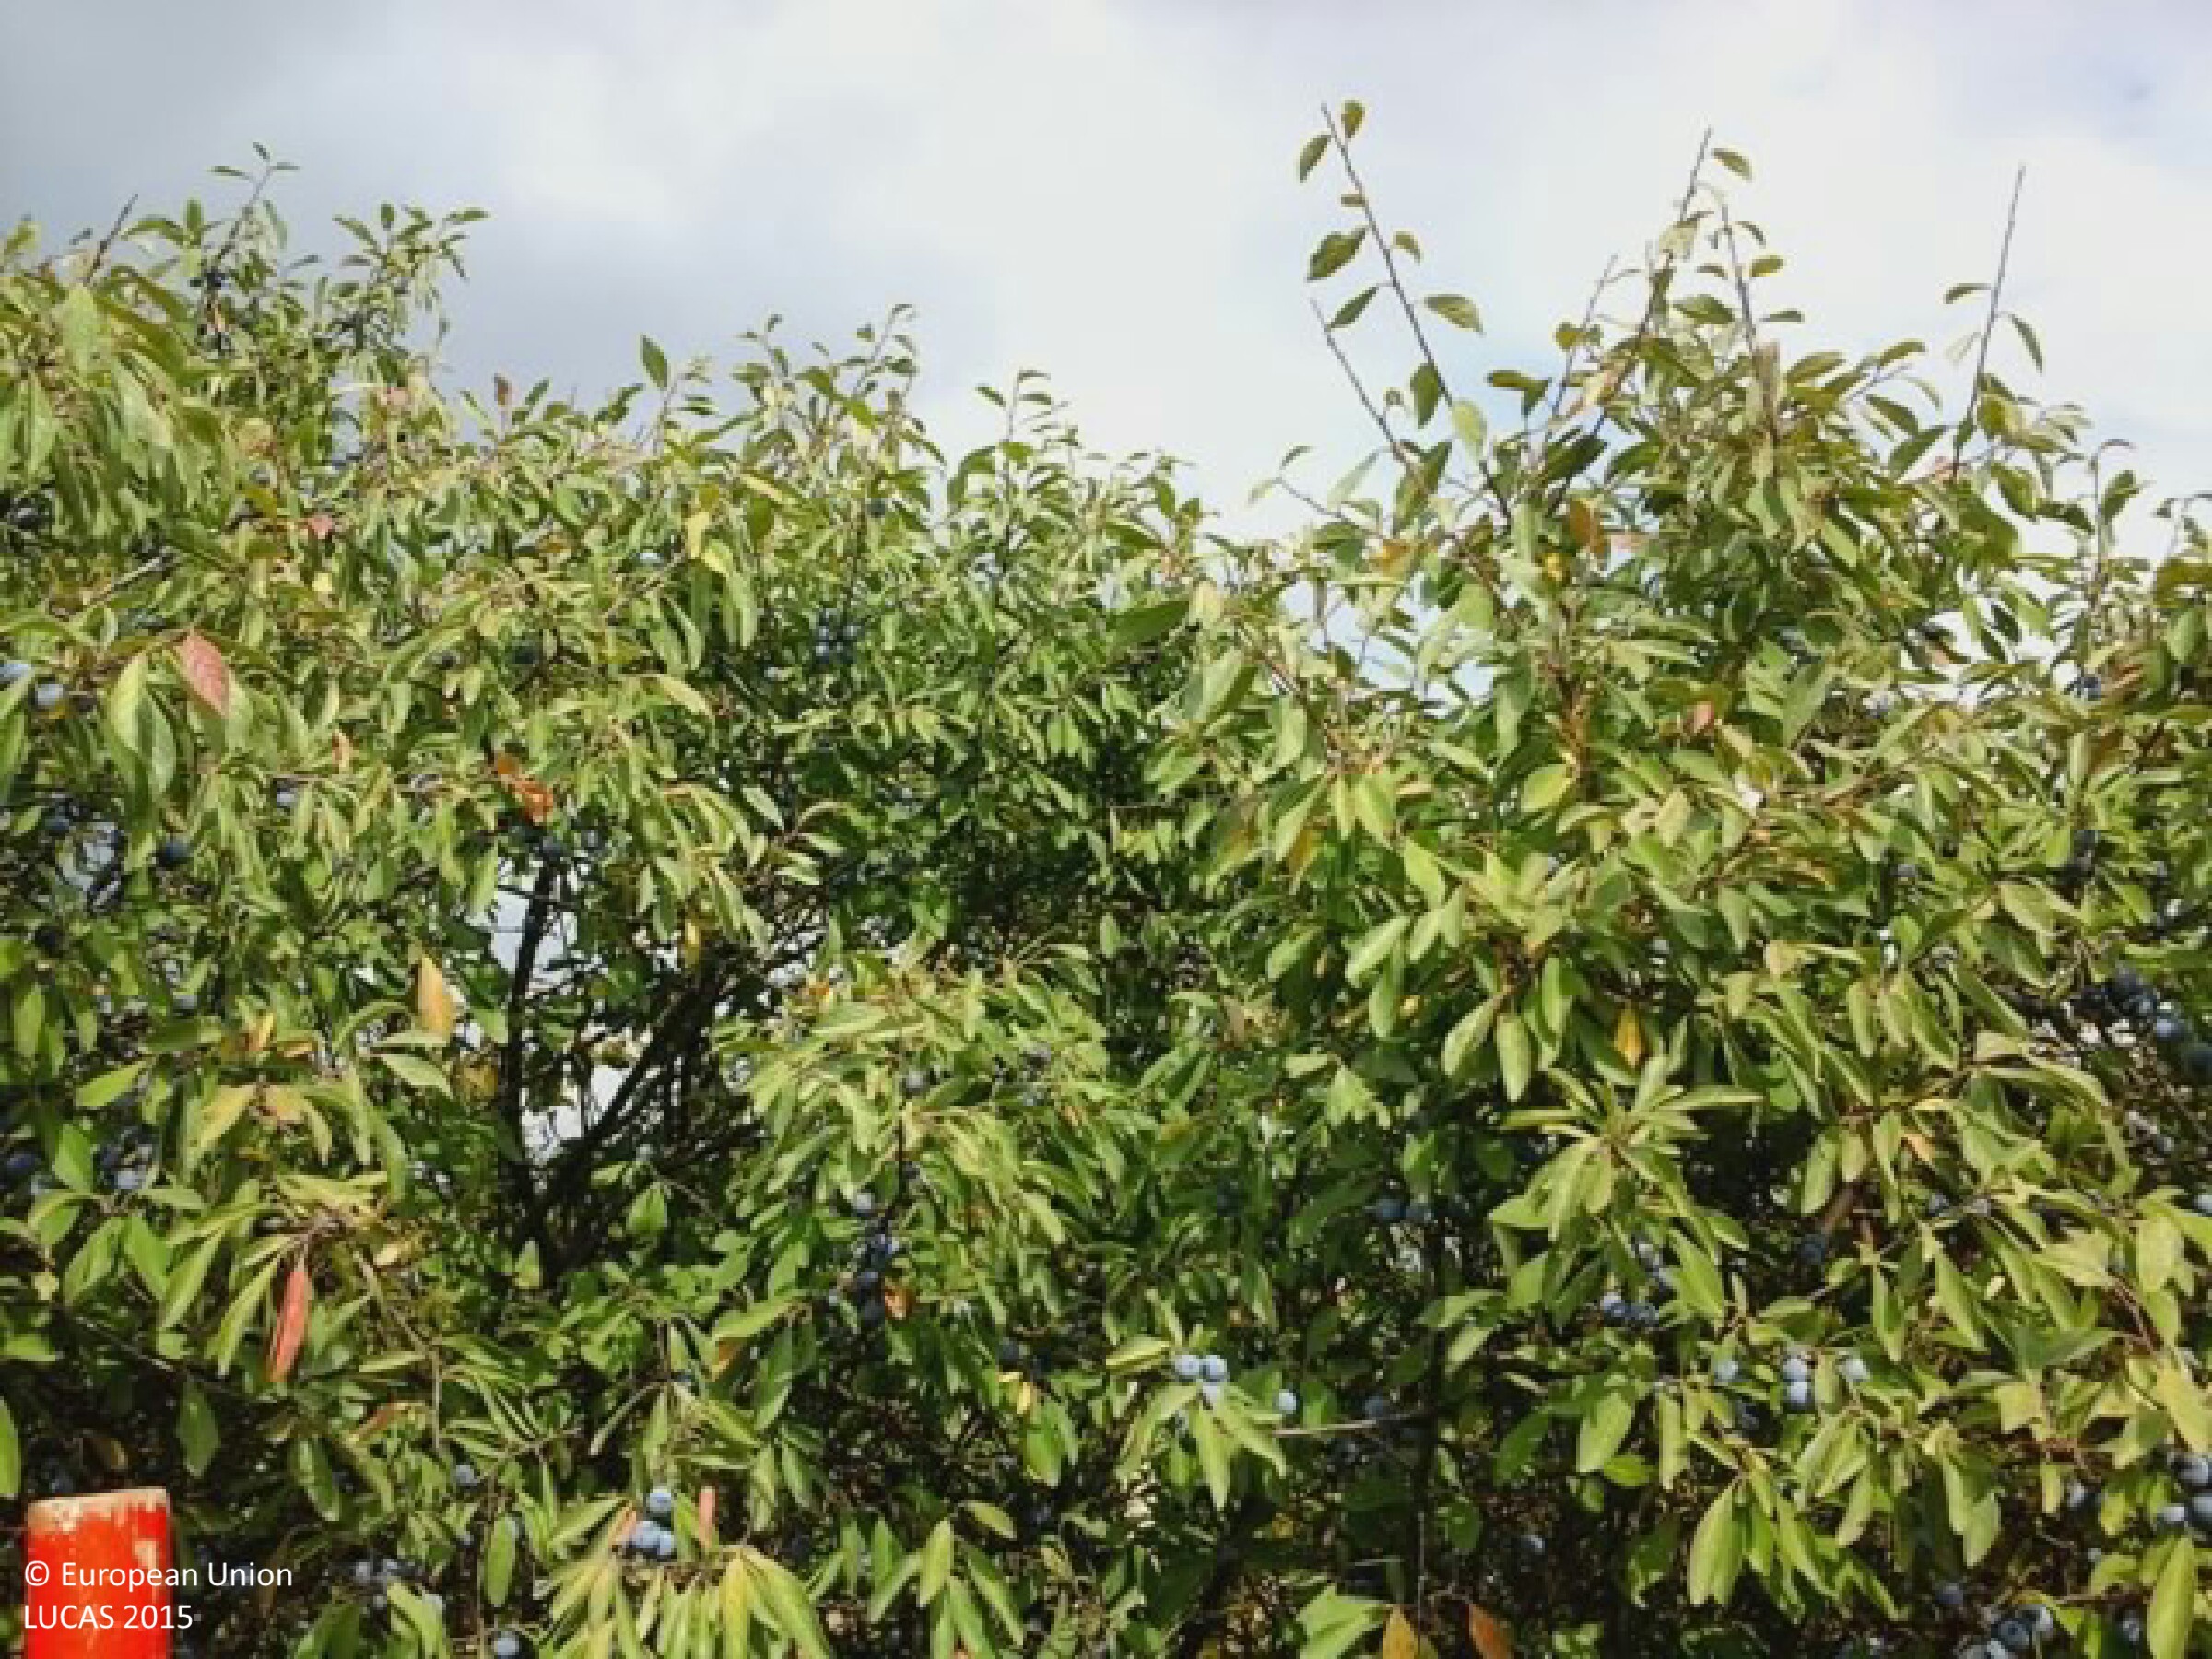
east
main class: Shrubland
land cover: Shrubland without tree cover
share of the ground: > 75 %
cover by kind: herbaceous plants 85 %, shrubs 15 %
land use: Agriculture (excluding fallow land and kitchen gardens)
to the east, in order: Shrubland without tree cover; Shruby margins; Shrubland without tree cover; Tracks; Shrubland without tree cover; Vineyards; Grassland without tree/shrub cover; Vineyards; Grassland without tree/shrub cover; Vineyards; Tracks; Grassland without tree/shrub cover
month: September
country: HU
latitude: 47.7673
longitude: 19.8055
